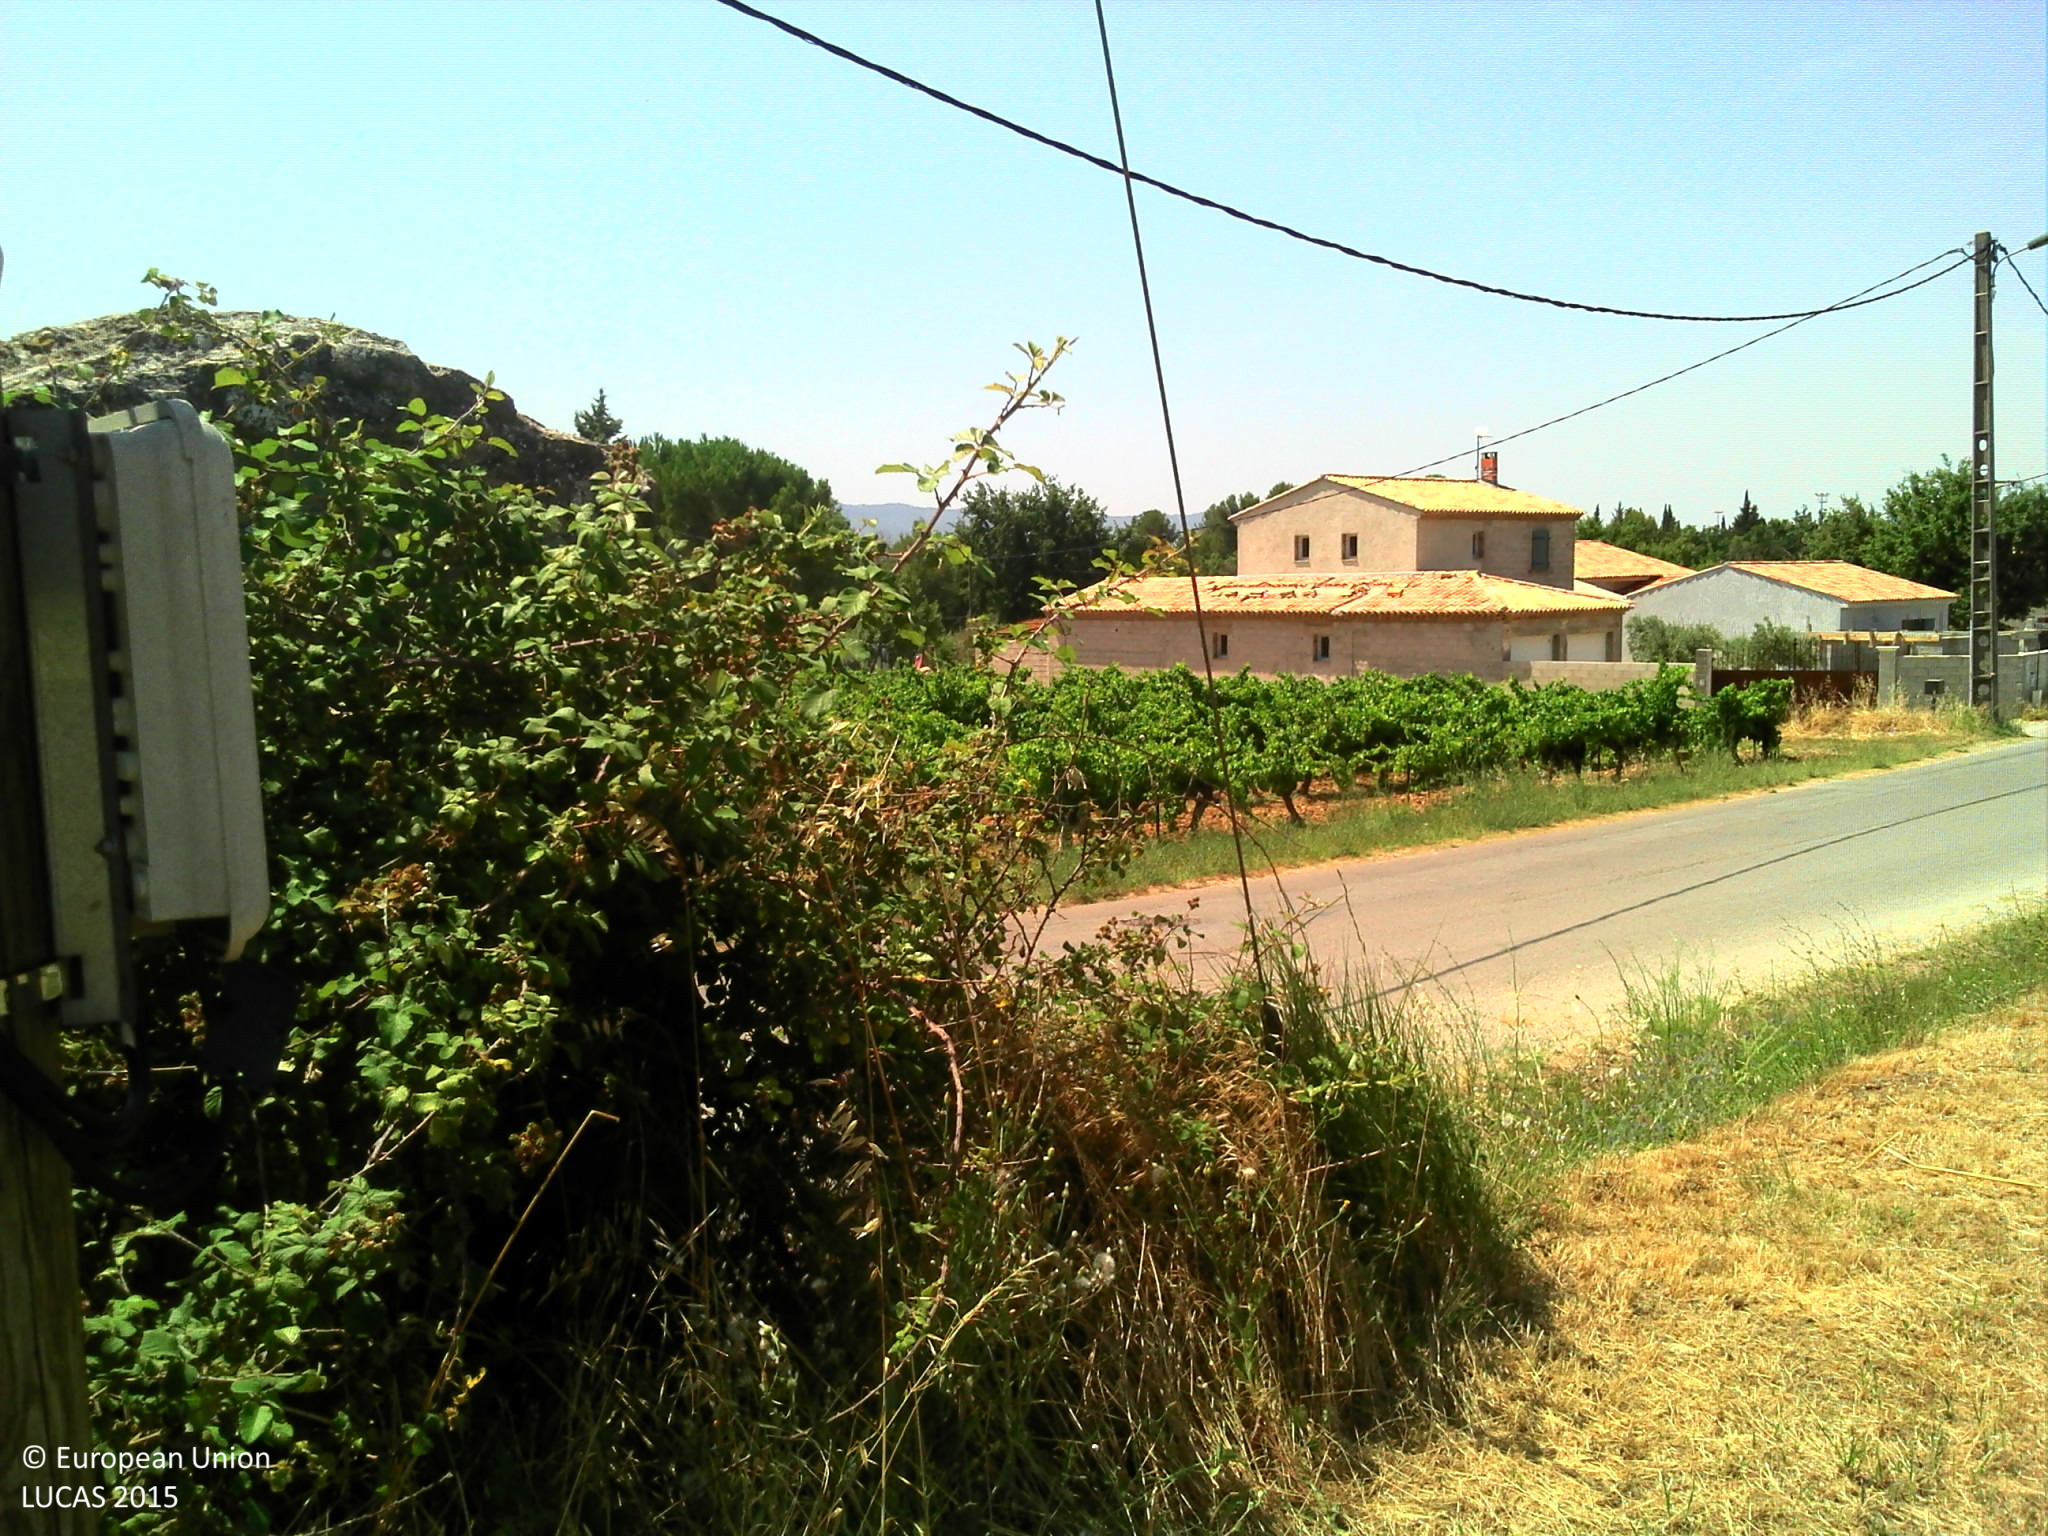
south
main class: Grassland
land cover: Grassland without tree/shrub cover
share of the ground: > 75 %
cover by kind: herbaceous plants 100 %
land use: Agriculture (excluding fallow land and kitchen gardens)
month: July
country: FR
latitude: 43.5045
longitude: 5.7424
